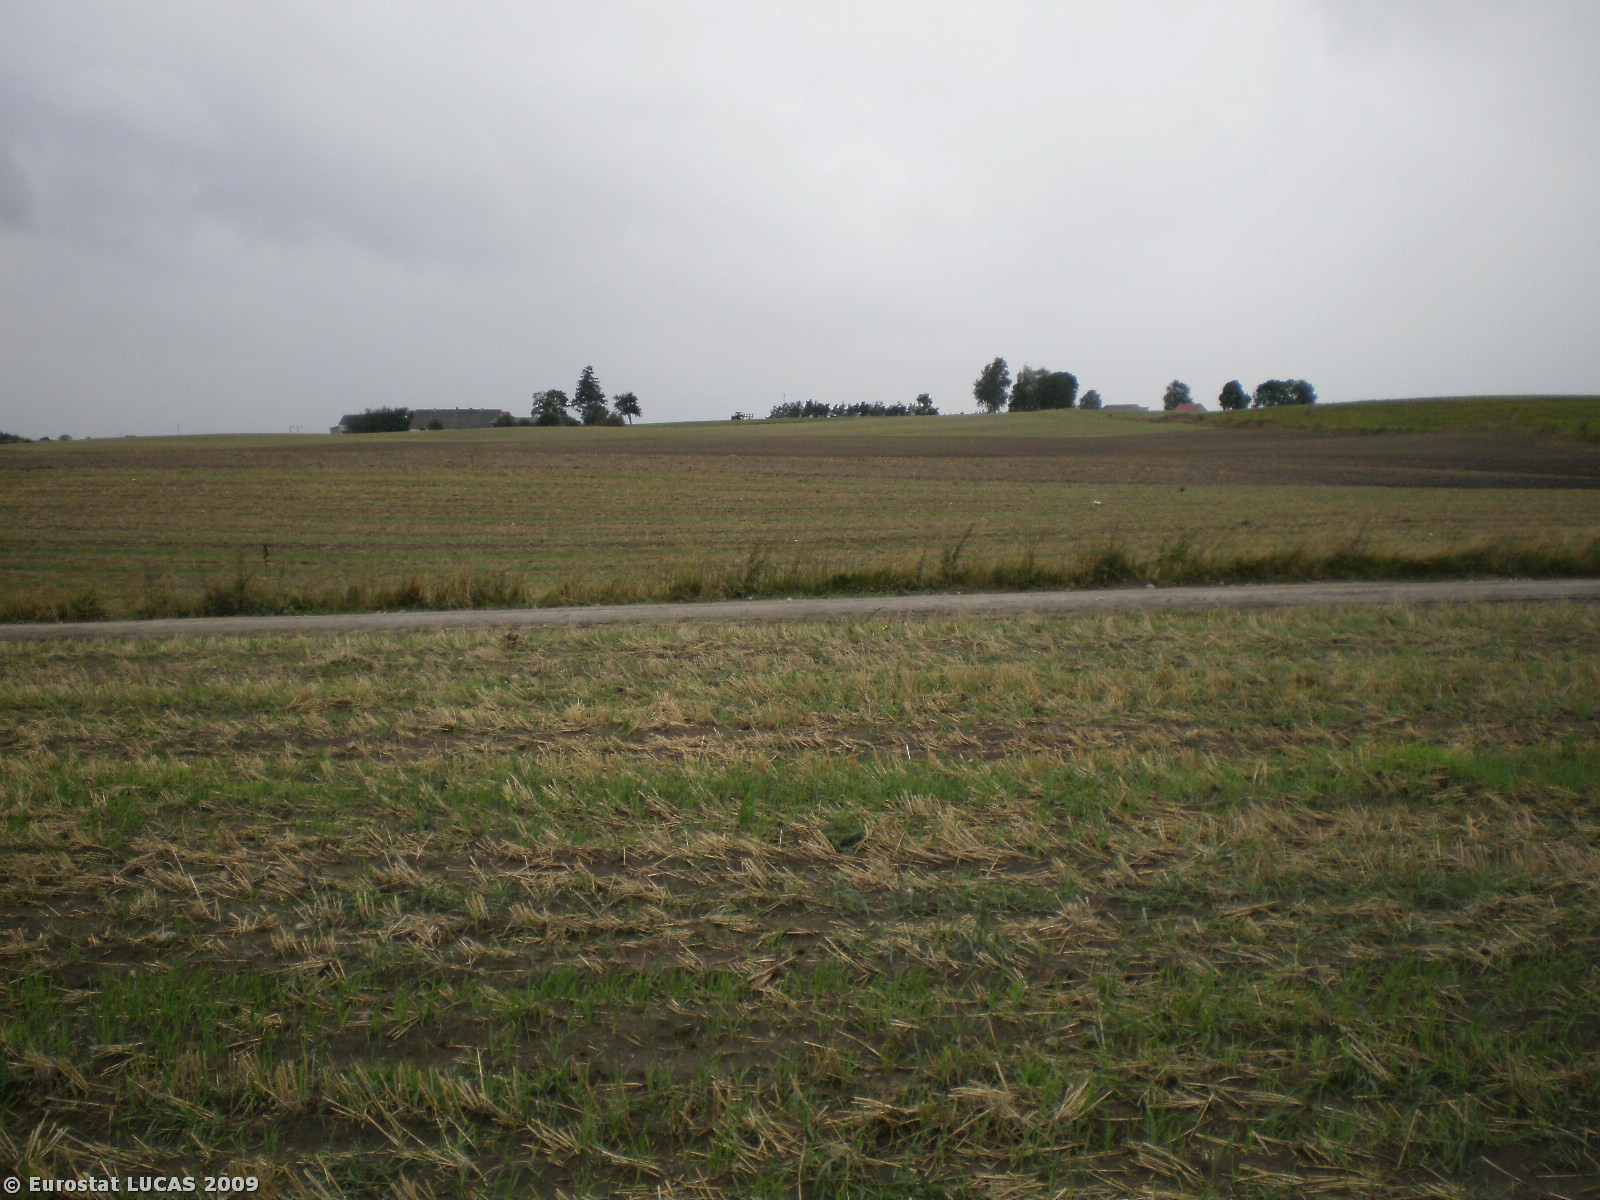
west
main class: Cropland
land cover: Triticale
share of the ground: < 10 %
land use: Agriculture (excluding fallow land and kitchen gardens)
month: September
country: PL
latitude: 53.9113
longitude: 17.7614
